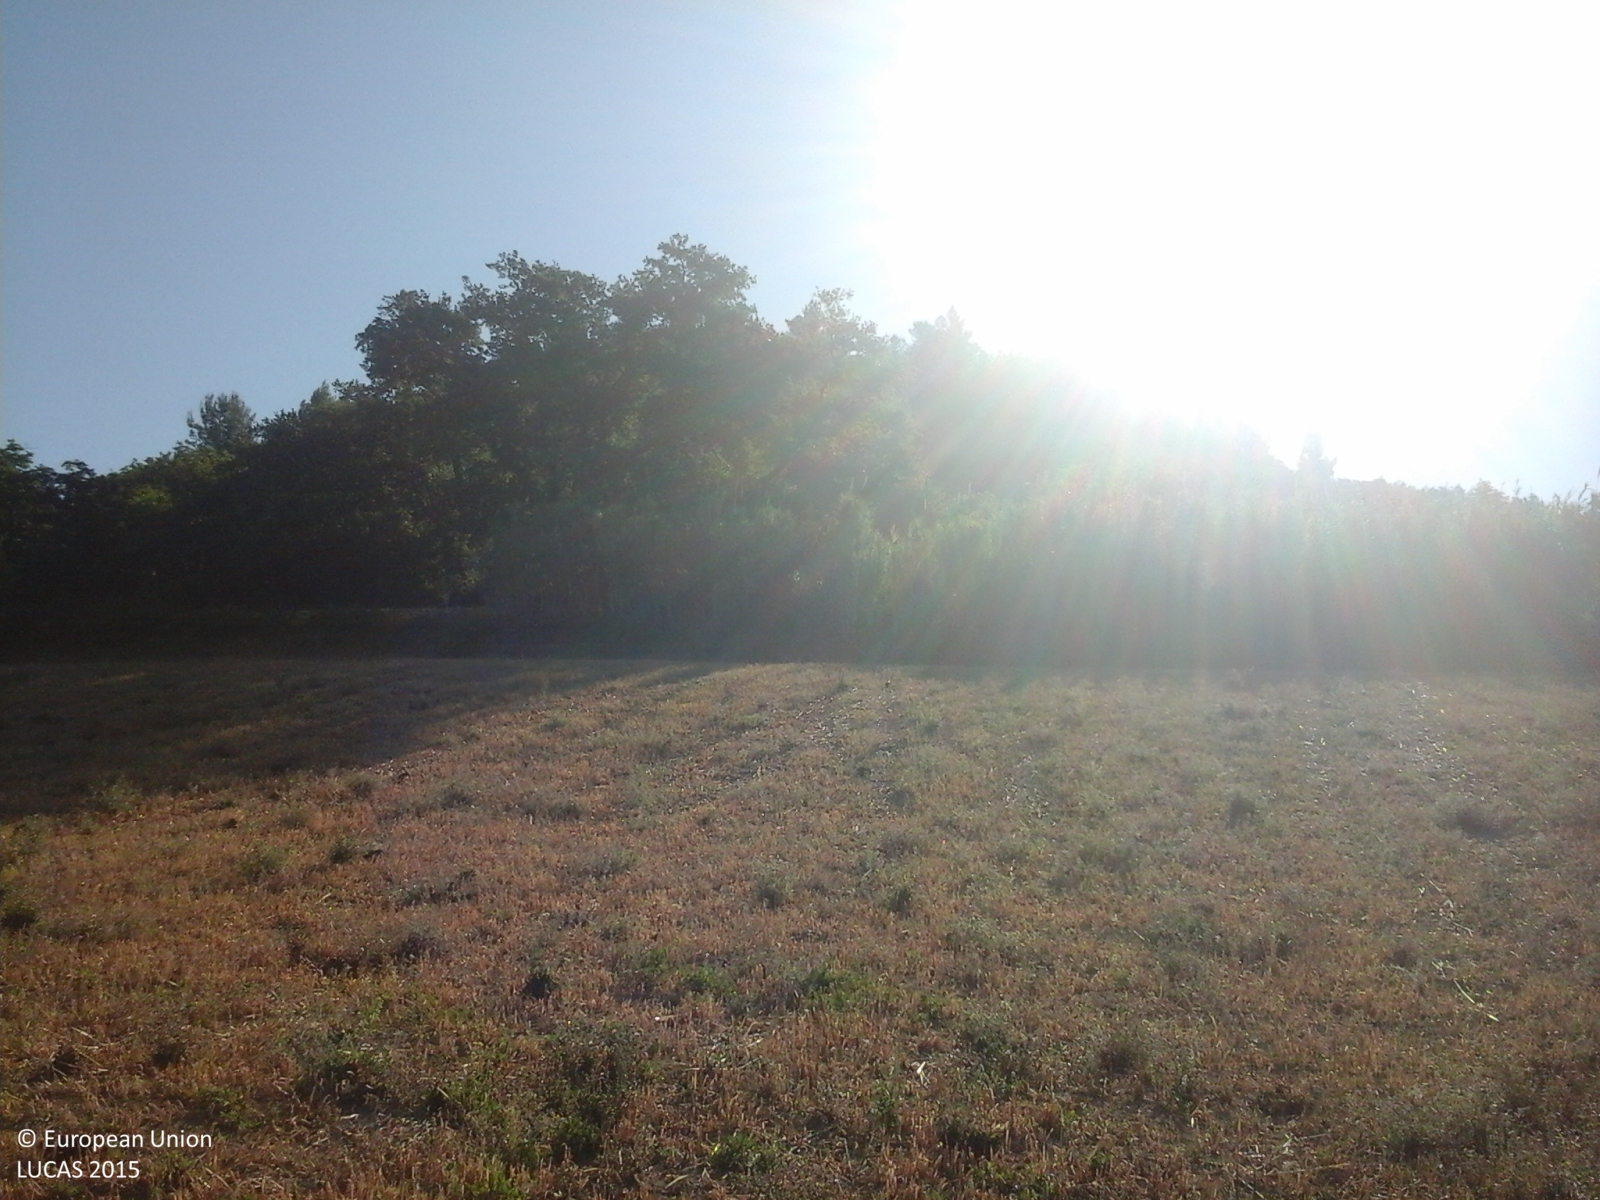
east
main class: Cropland
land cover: Oats
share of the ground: > 75 %
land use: Agriculture (excluding fallow land and kitchen gardens)
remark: Harvested field
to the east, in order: Oats; Abandoned hedges; Grass margins; Paved roads, cycling and walking lanes; Grass margins; Olive groves; Grassland without tree/shrub cover; Shrubland with sparse tree cover; Broadleaved woodland
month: July
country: IT
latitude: 42.3208
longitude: 14.0281
